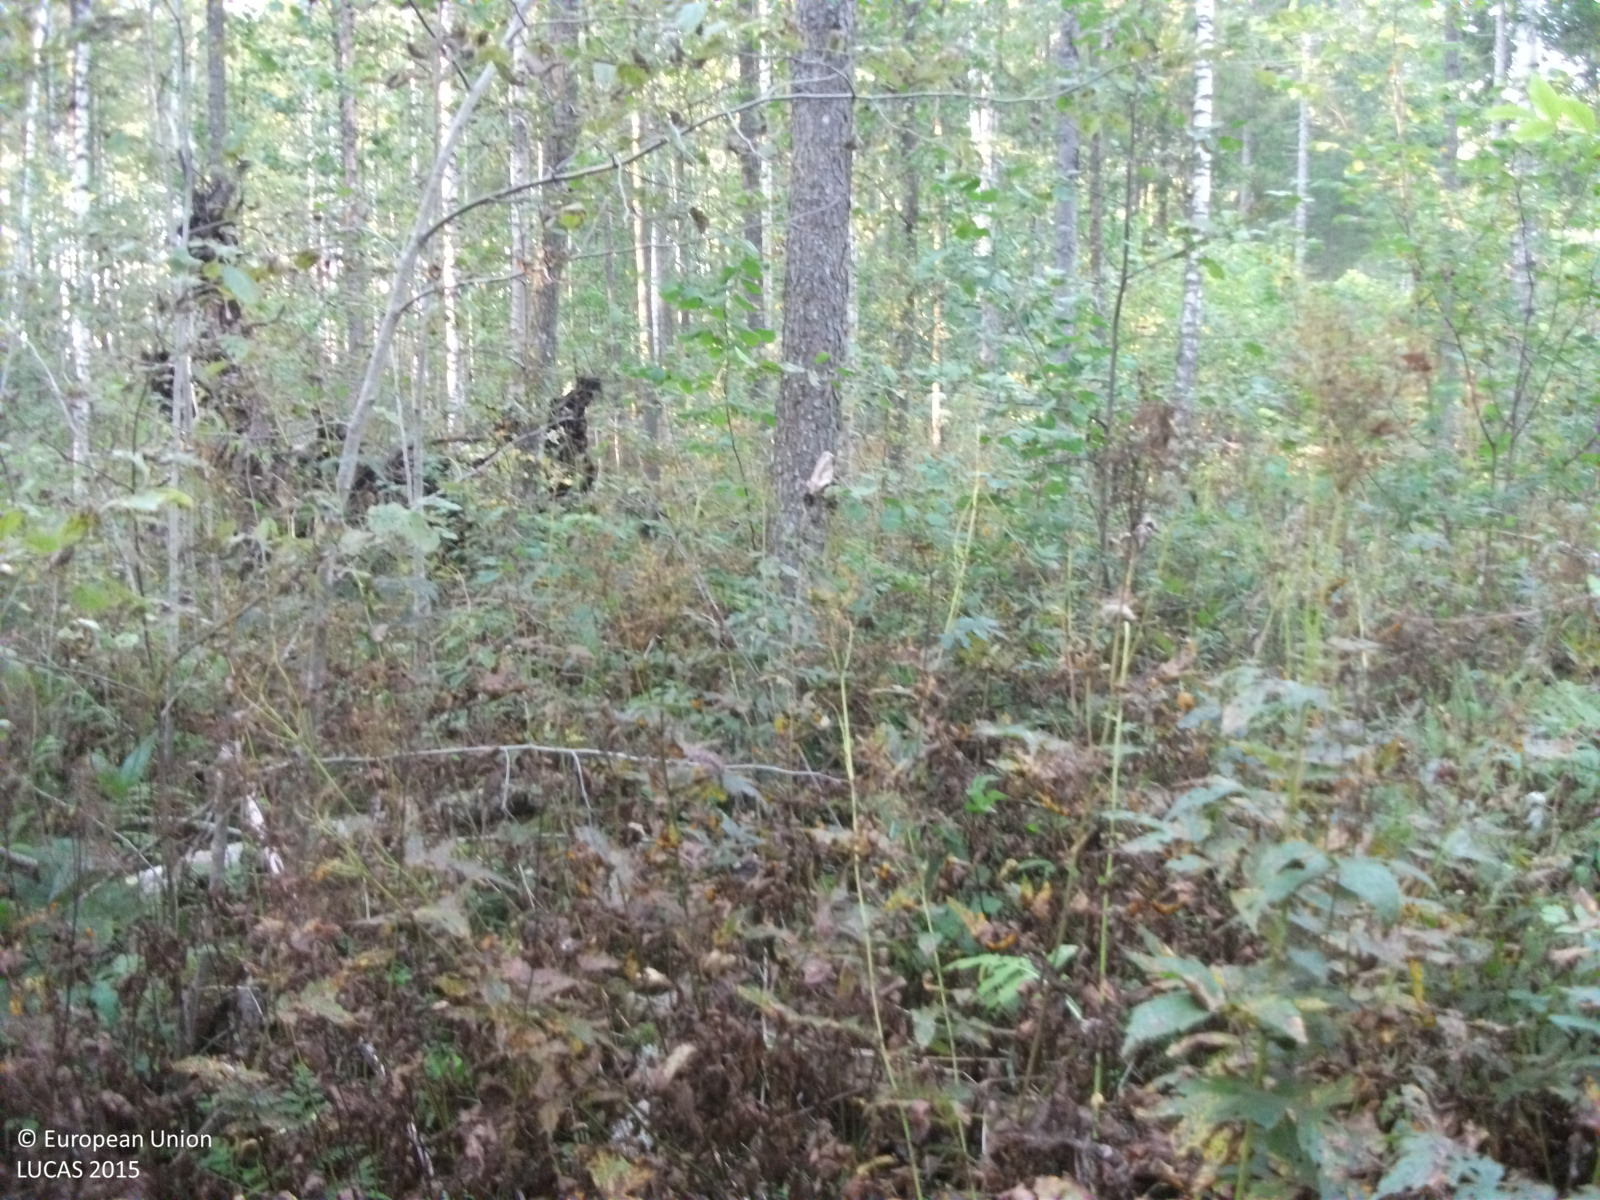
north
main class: Woodland
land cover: Broadleaved woodland
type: mire and swamp forests
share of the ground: > 75 %
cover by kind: broadleaved forest trees 80 %, herbaceous plants 10 %, shrubs 5 %, lichens and mosses 5 %
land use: Forestry
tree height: > 5 m
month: September
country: LV
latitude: 57.8199
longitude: 24.7582
